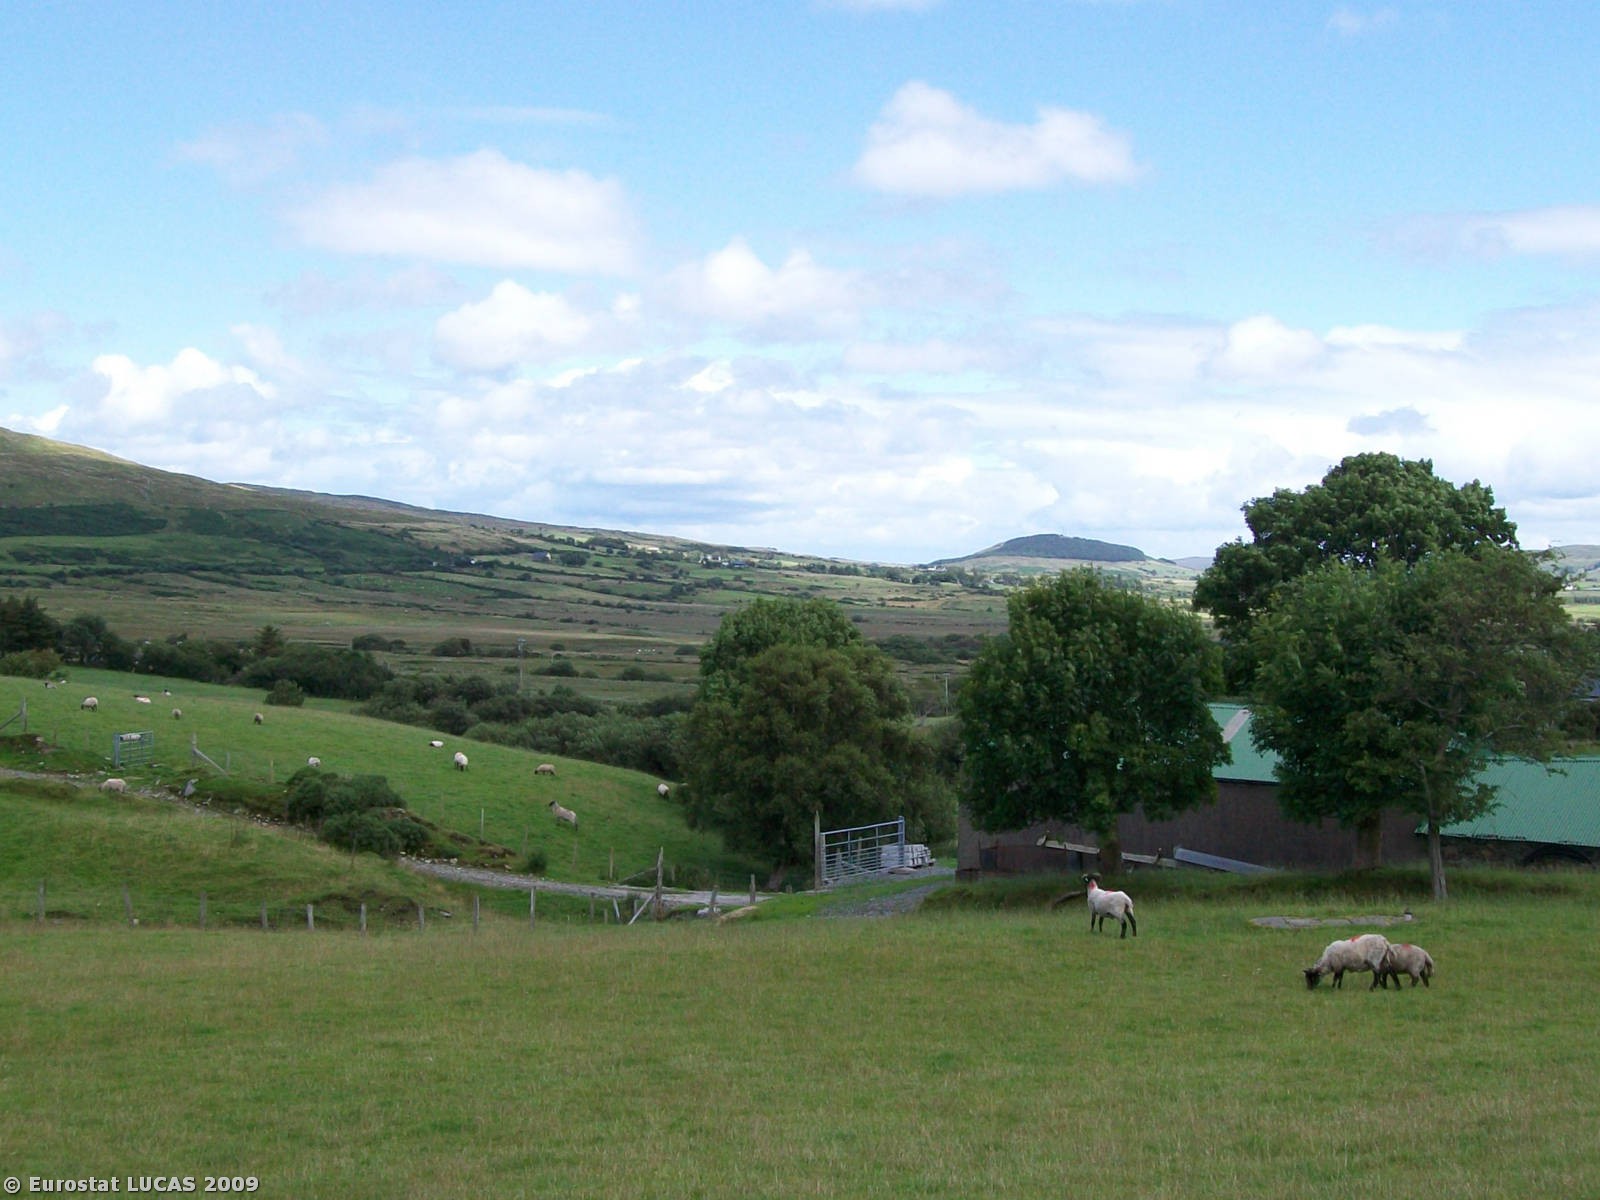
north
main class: Grassland
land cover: Grassland without tree/shrub cover
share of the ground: > 75 %
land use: Agriculture (excluding fallow land and kitchen gardens)
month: July
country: IE
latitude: 53.6982
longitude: -9.6405
